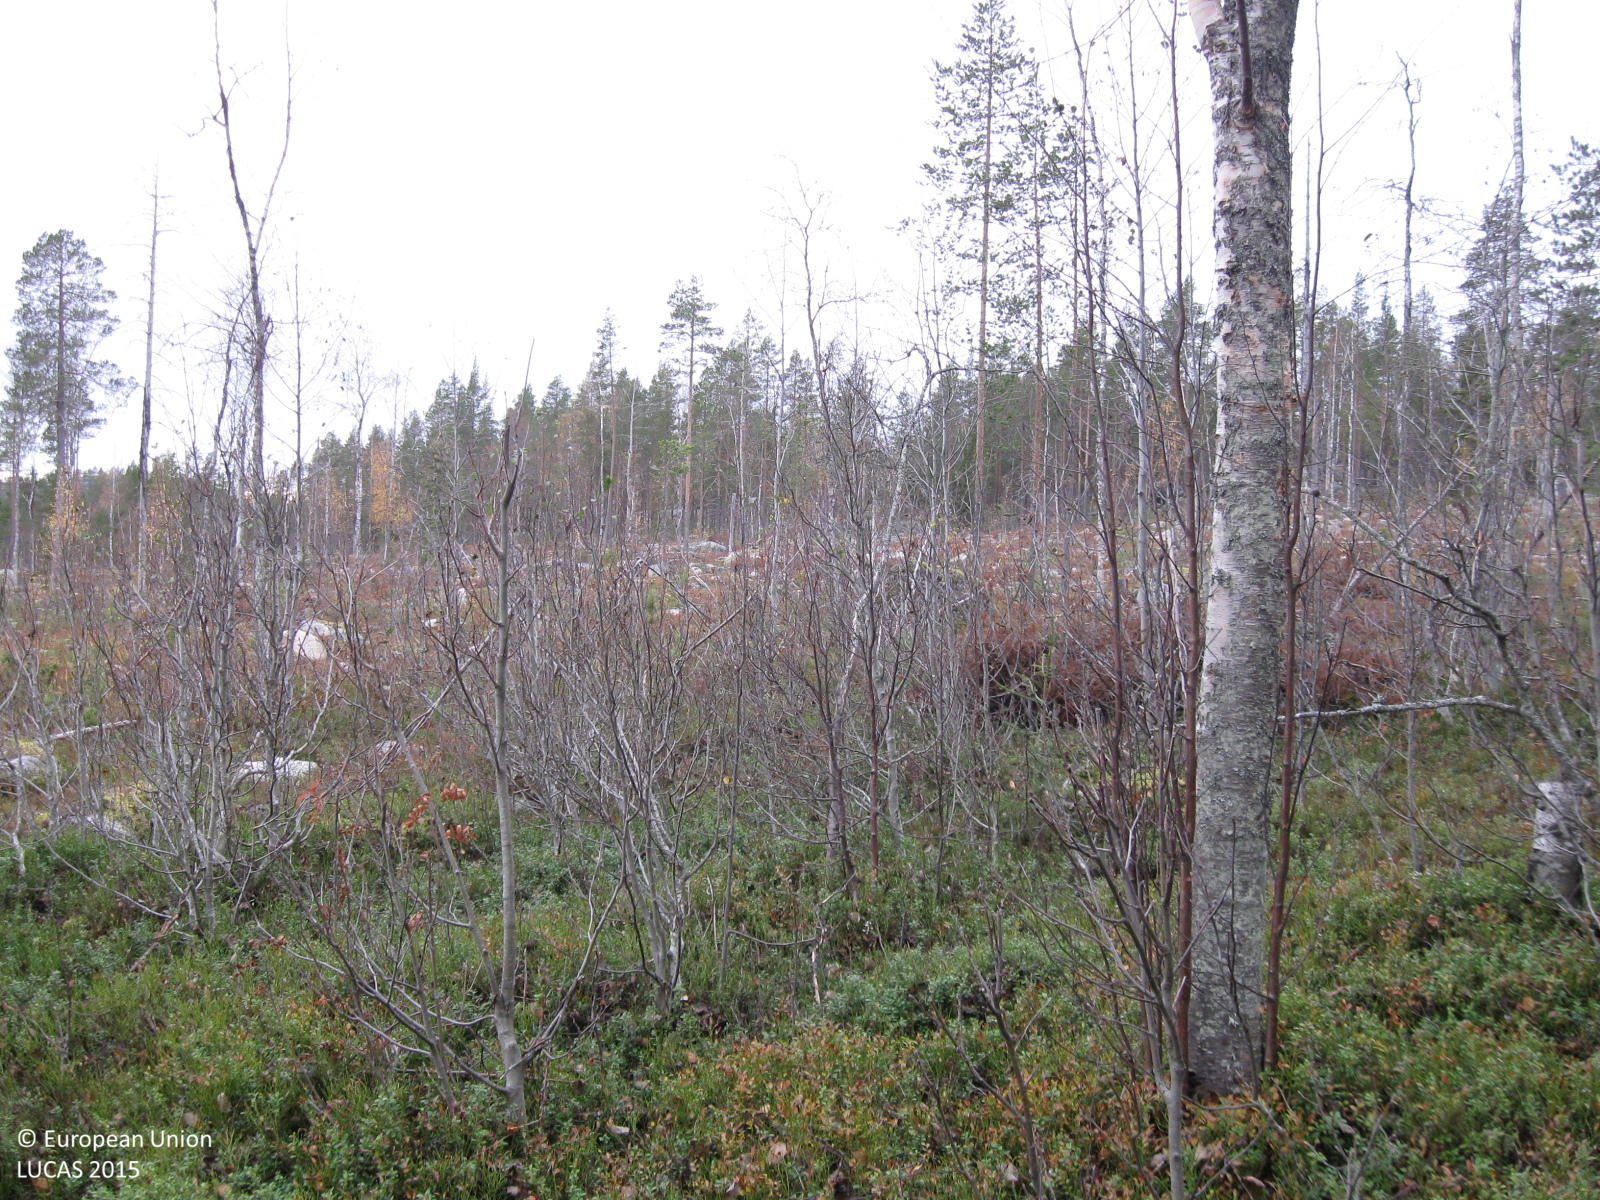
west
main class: Woodland
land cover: Broadleaved woodland
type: non-riverine alder, birch or aspen forest
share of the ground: > 75 %
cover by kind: broadleaved forest trees 75 %, herbaceous plants 10 %, coniferous forest trees 5 %, shrubs 5 %, lichens and mosses 5 %
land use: Forestry
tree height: > 5 m
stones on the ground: < 10 %
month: October
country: SE
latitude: 66.0601
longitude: 22.0980
